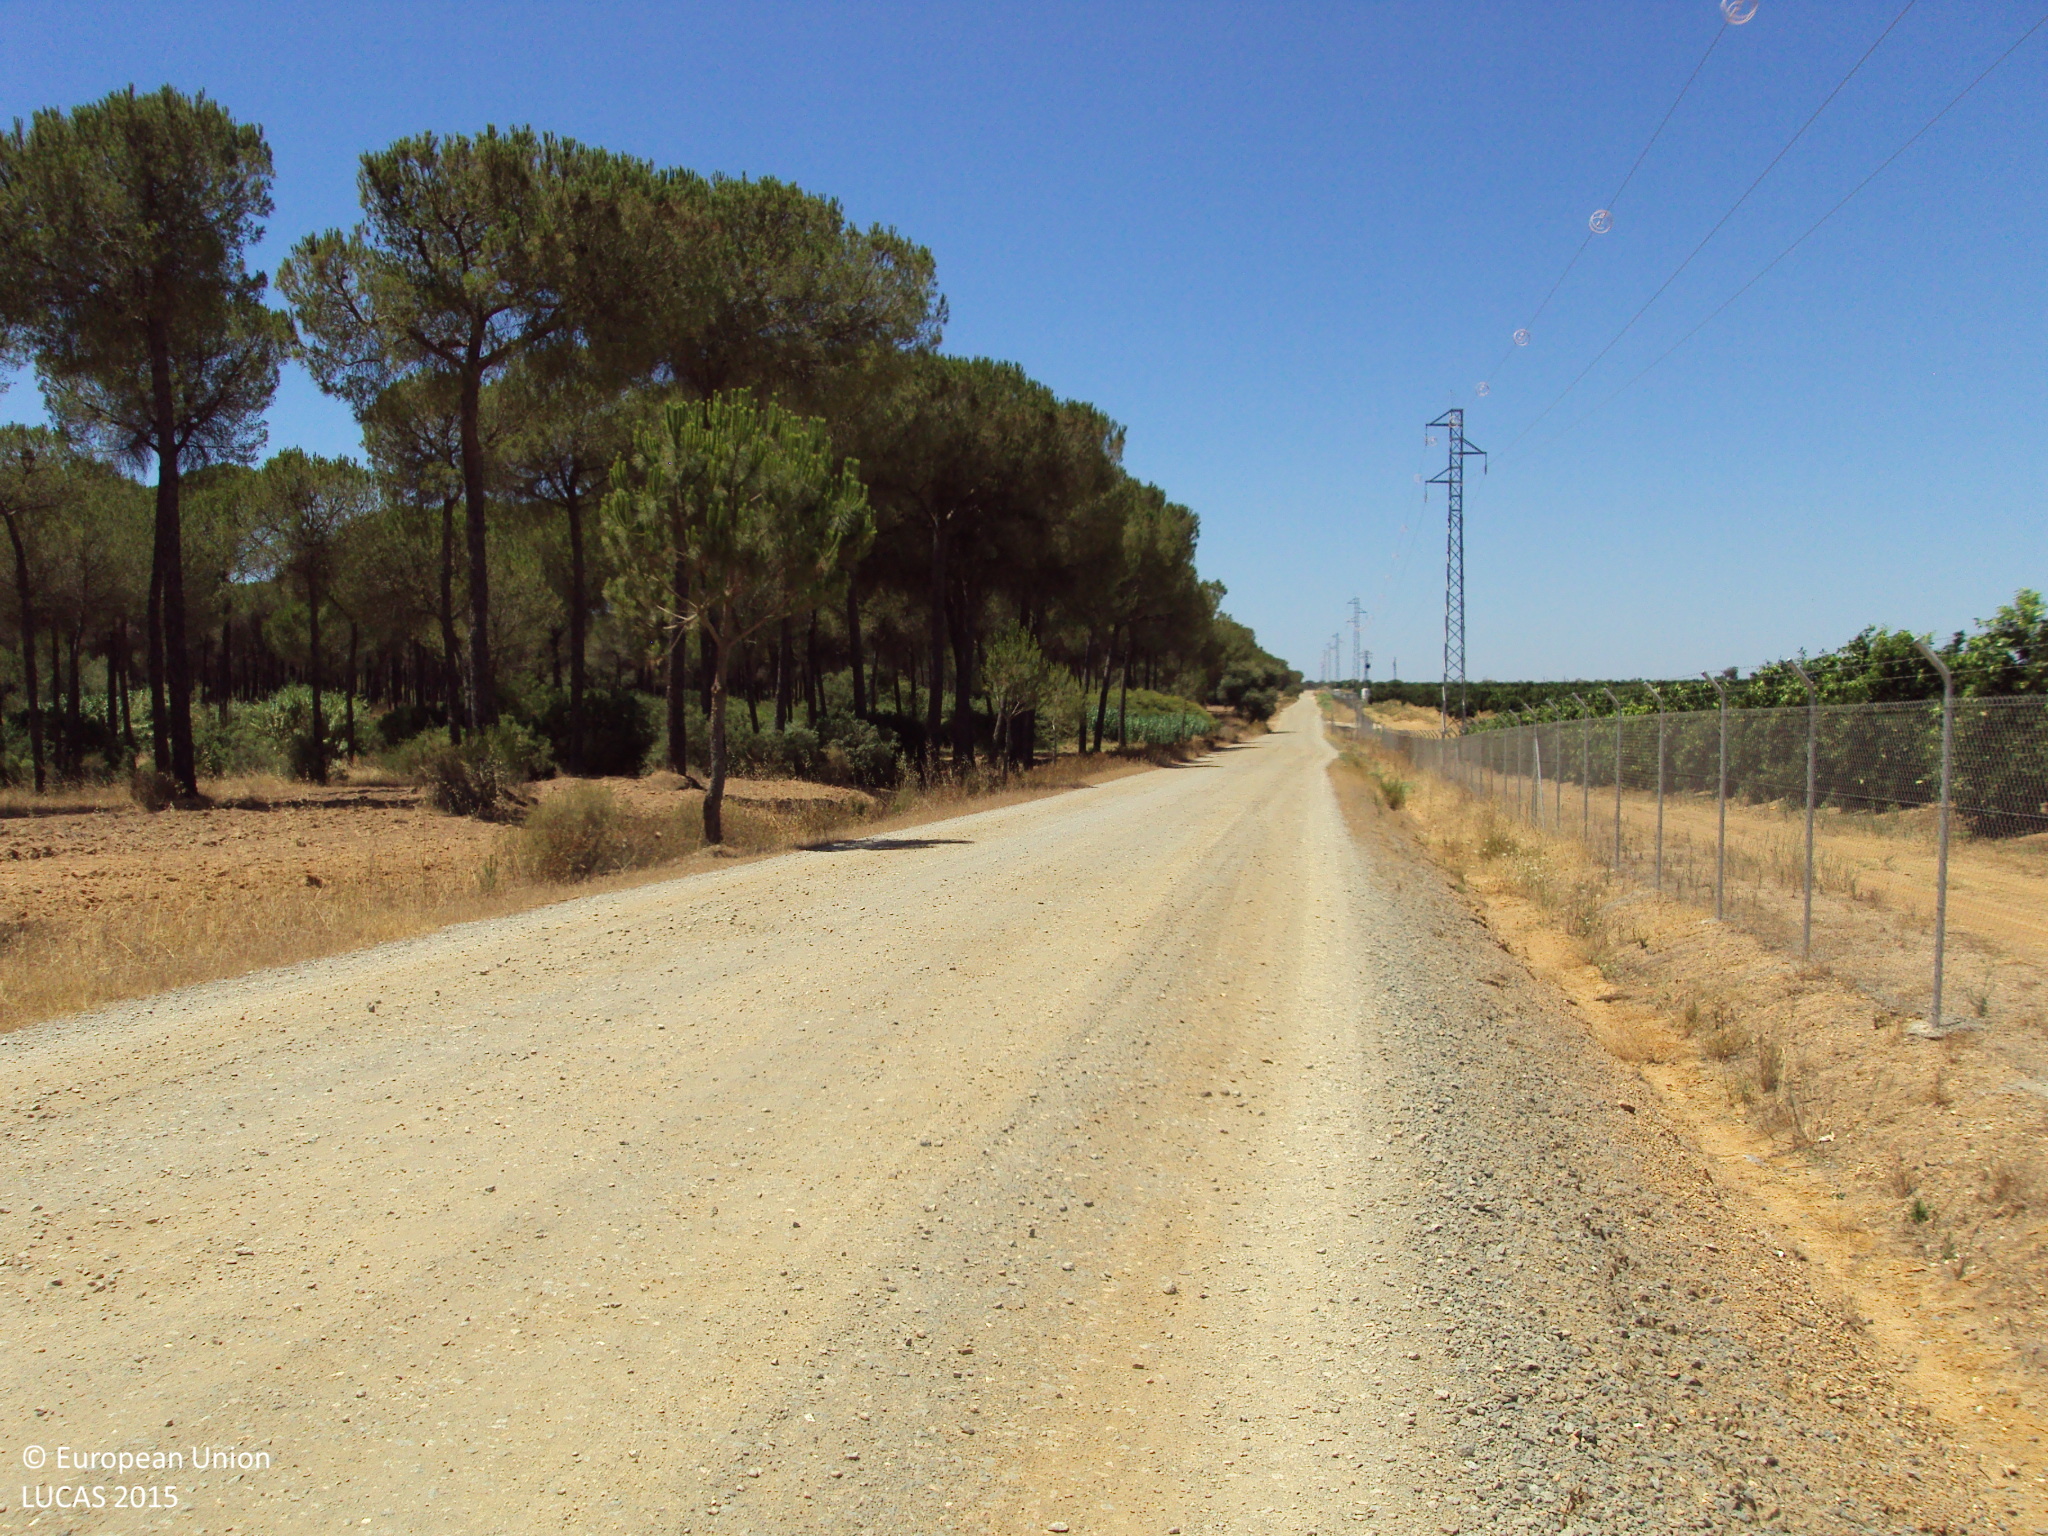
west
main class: Cropland
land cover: Oranges
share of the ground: > 75 %
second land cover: Spontaneously vegetated surfaces
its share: 10 - 25 %
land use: Agriculture (excluding fallow land and kitchen gardens)
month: July
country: ES
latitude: 37.1934
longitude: -6.3269
